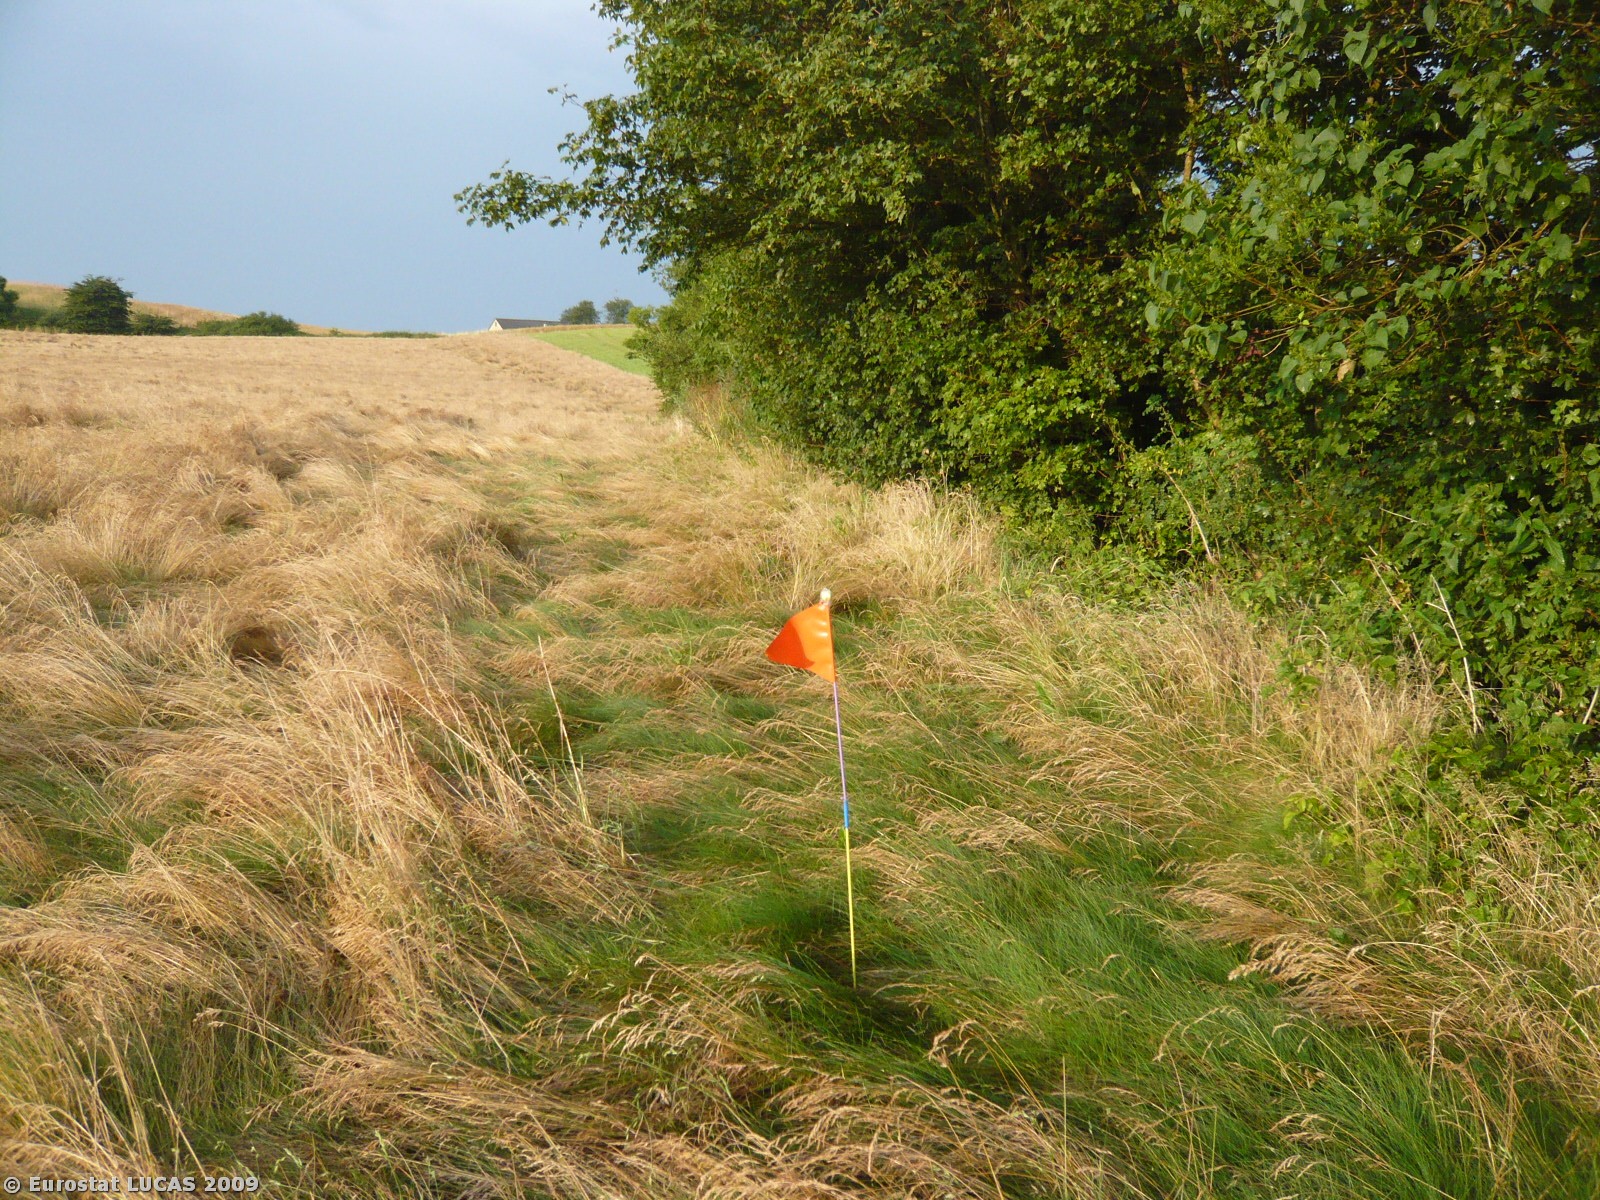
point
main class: Cropland
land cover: Temporary grasslands
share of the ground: > 75 %
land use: Agriculture (excluding fallow land and kitchen gardens)
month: July
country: DK
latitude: 55.6773
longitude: 11.3504
